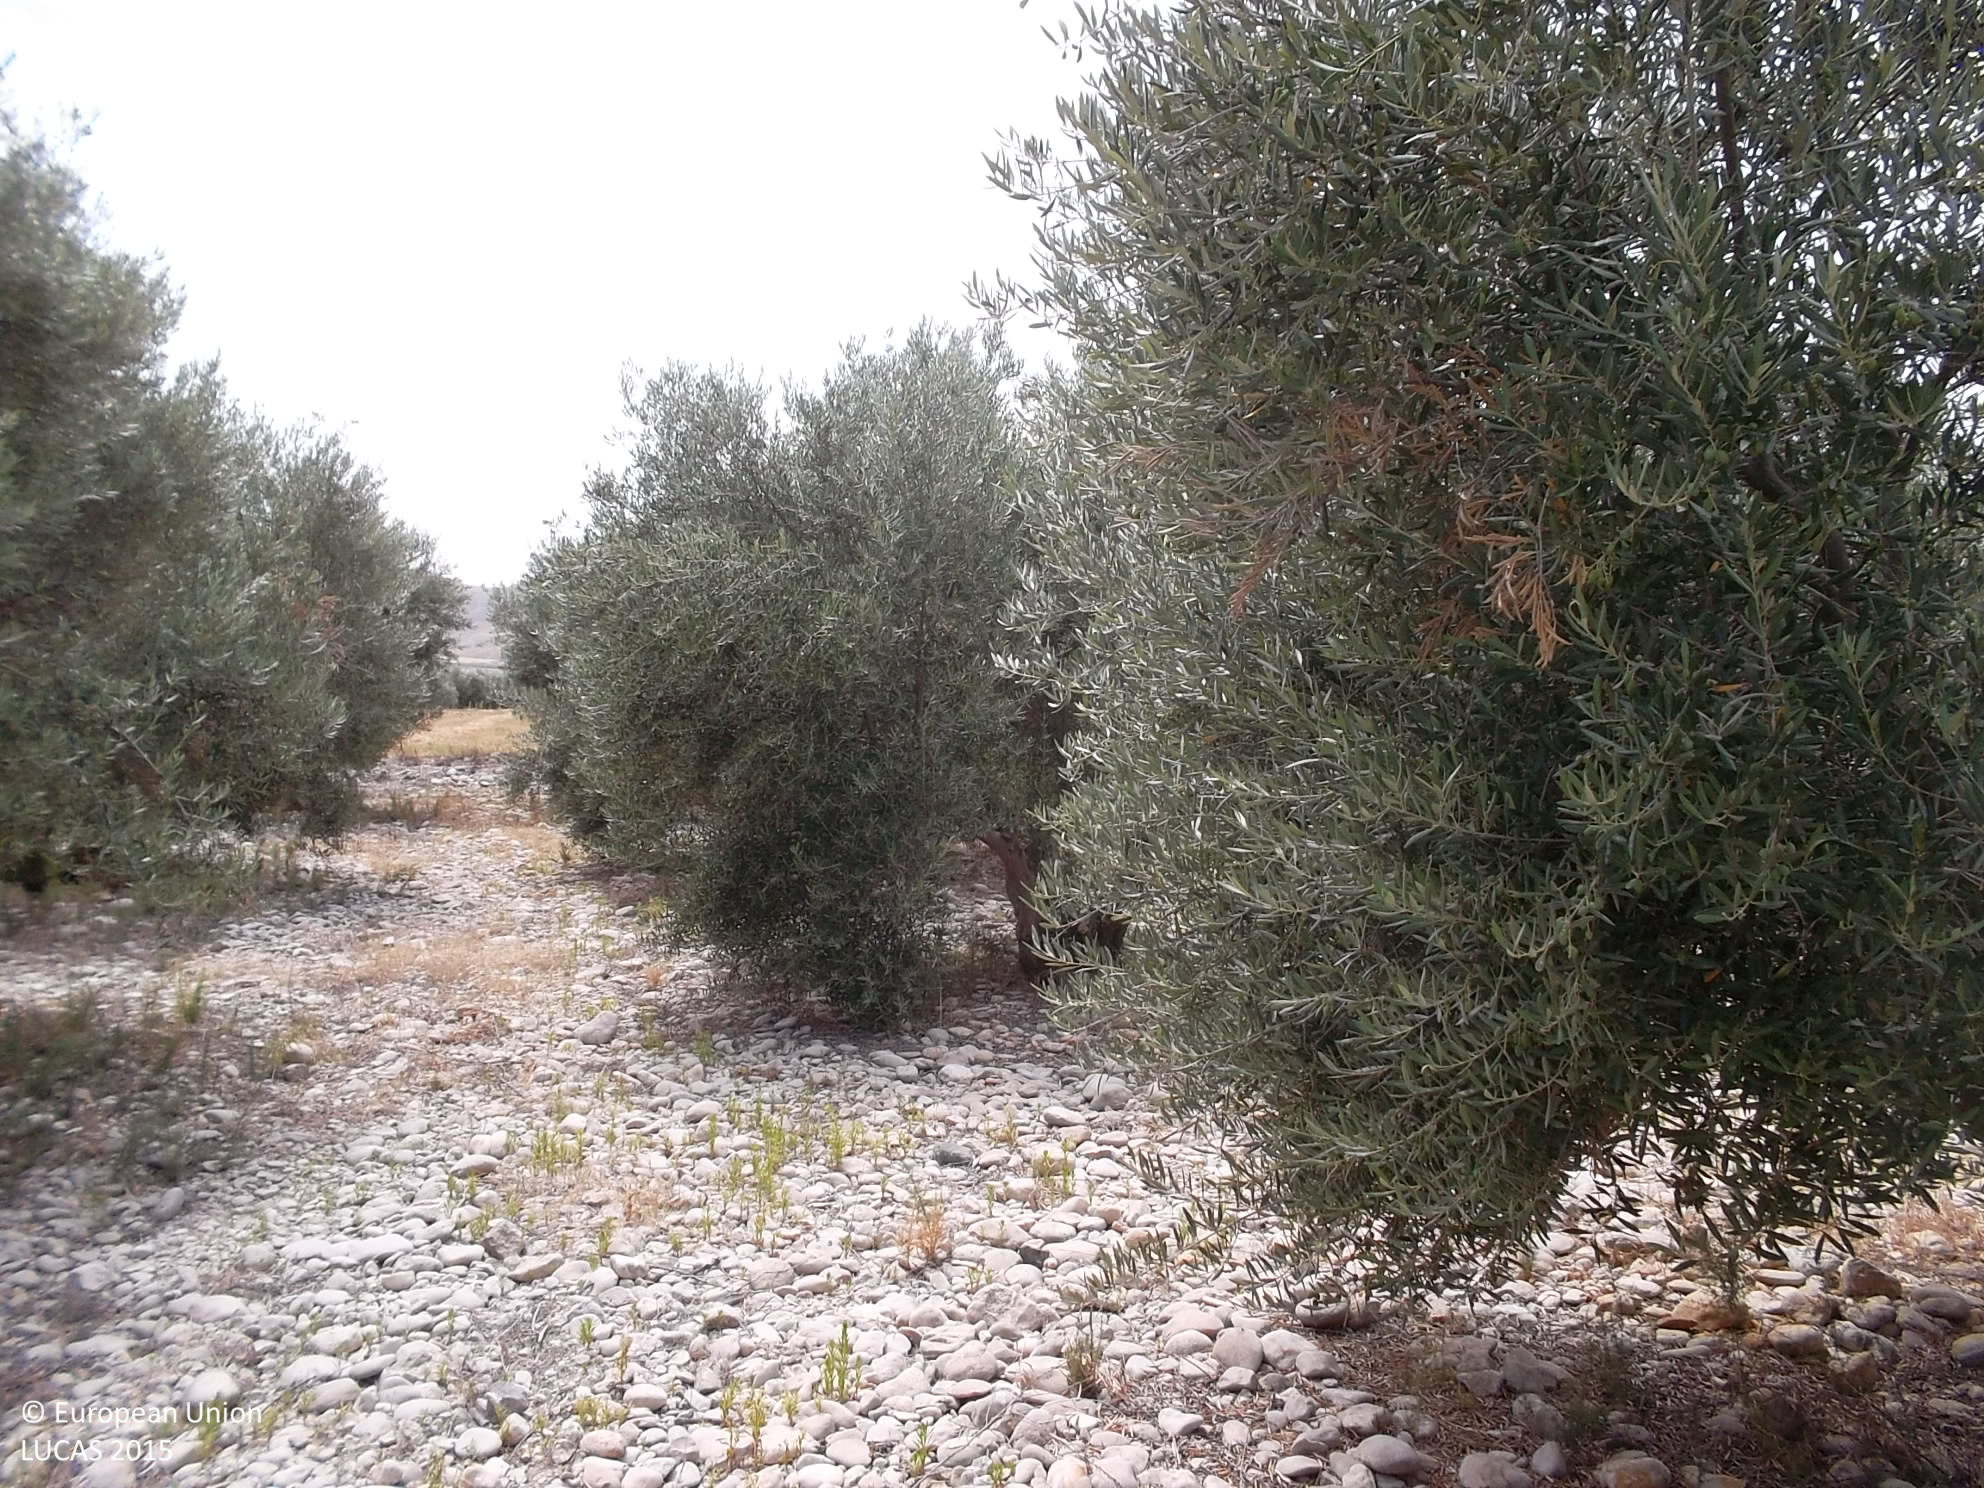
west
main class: Cropland
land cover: Olive groves
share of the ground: 50 - 75 %
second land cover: Other bare soil
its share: > 75 %
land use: Agriculture (excluding fallow land and kitchen gardens)
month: July
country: ES
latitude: 37.6001
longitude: -2.7537
